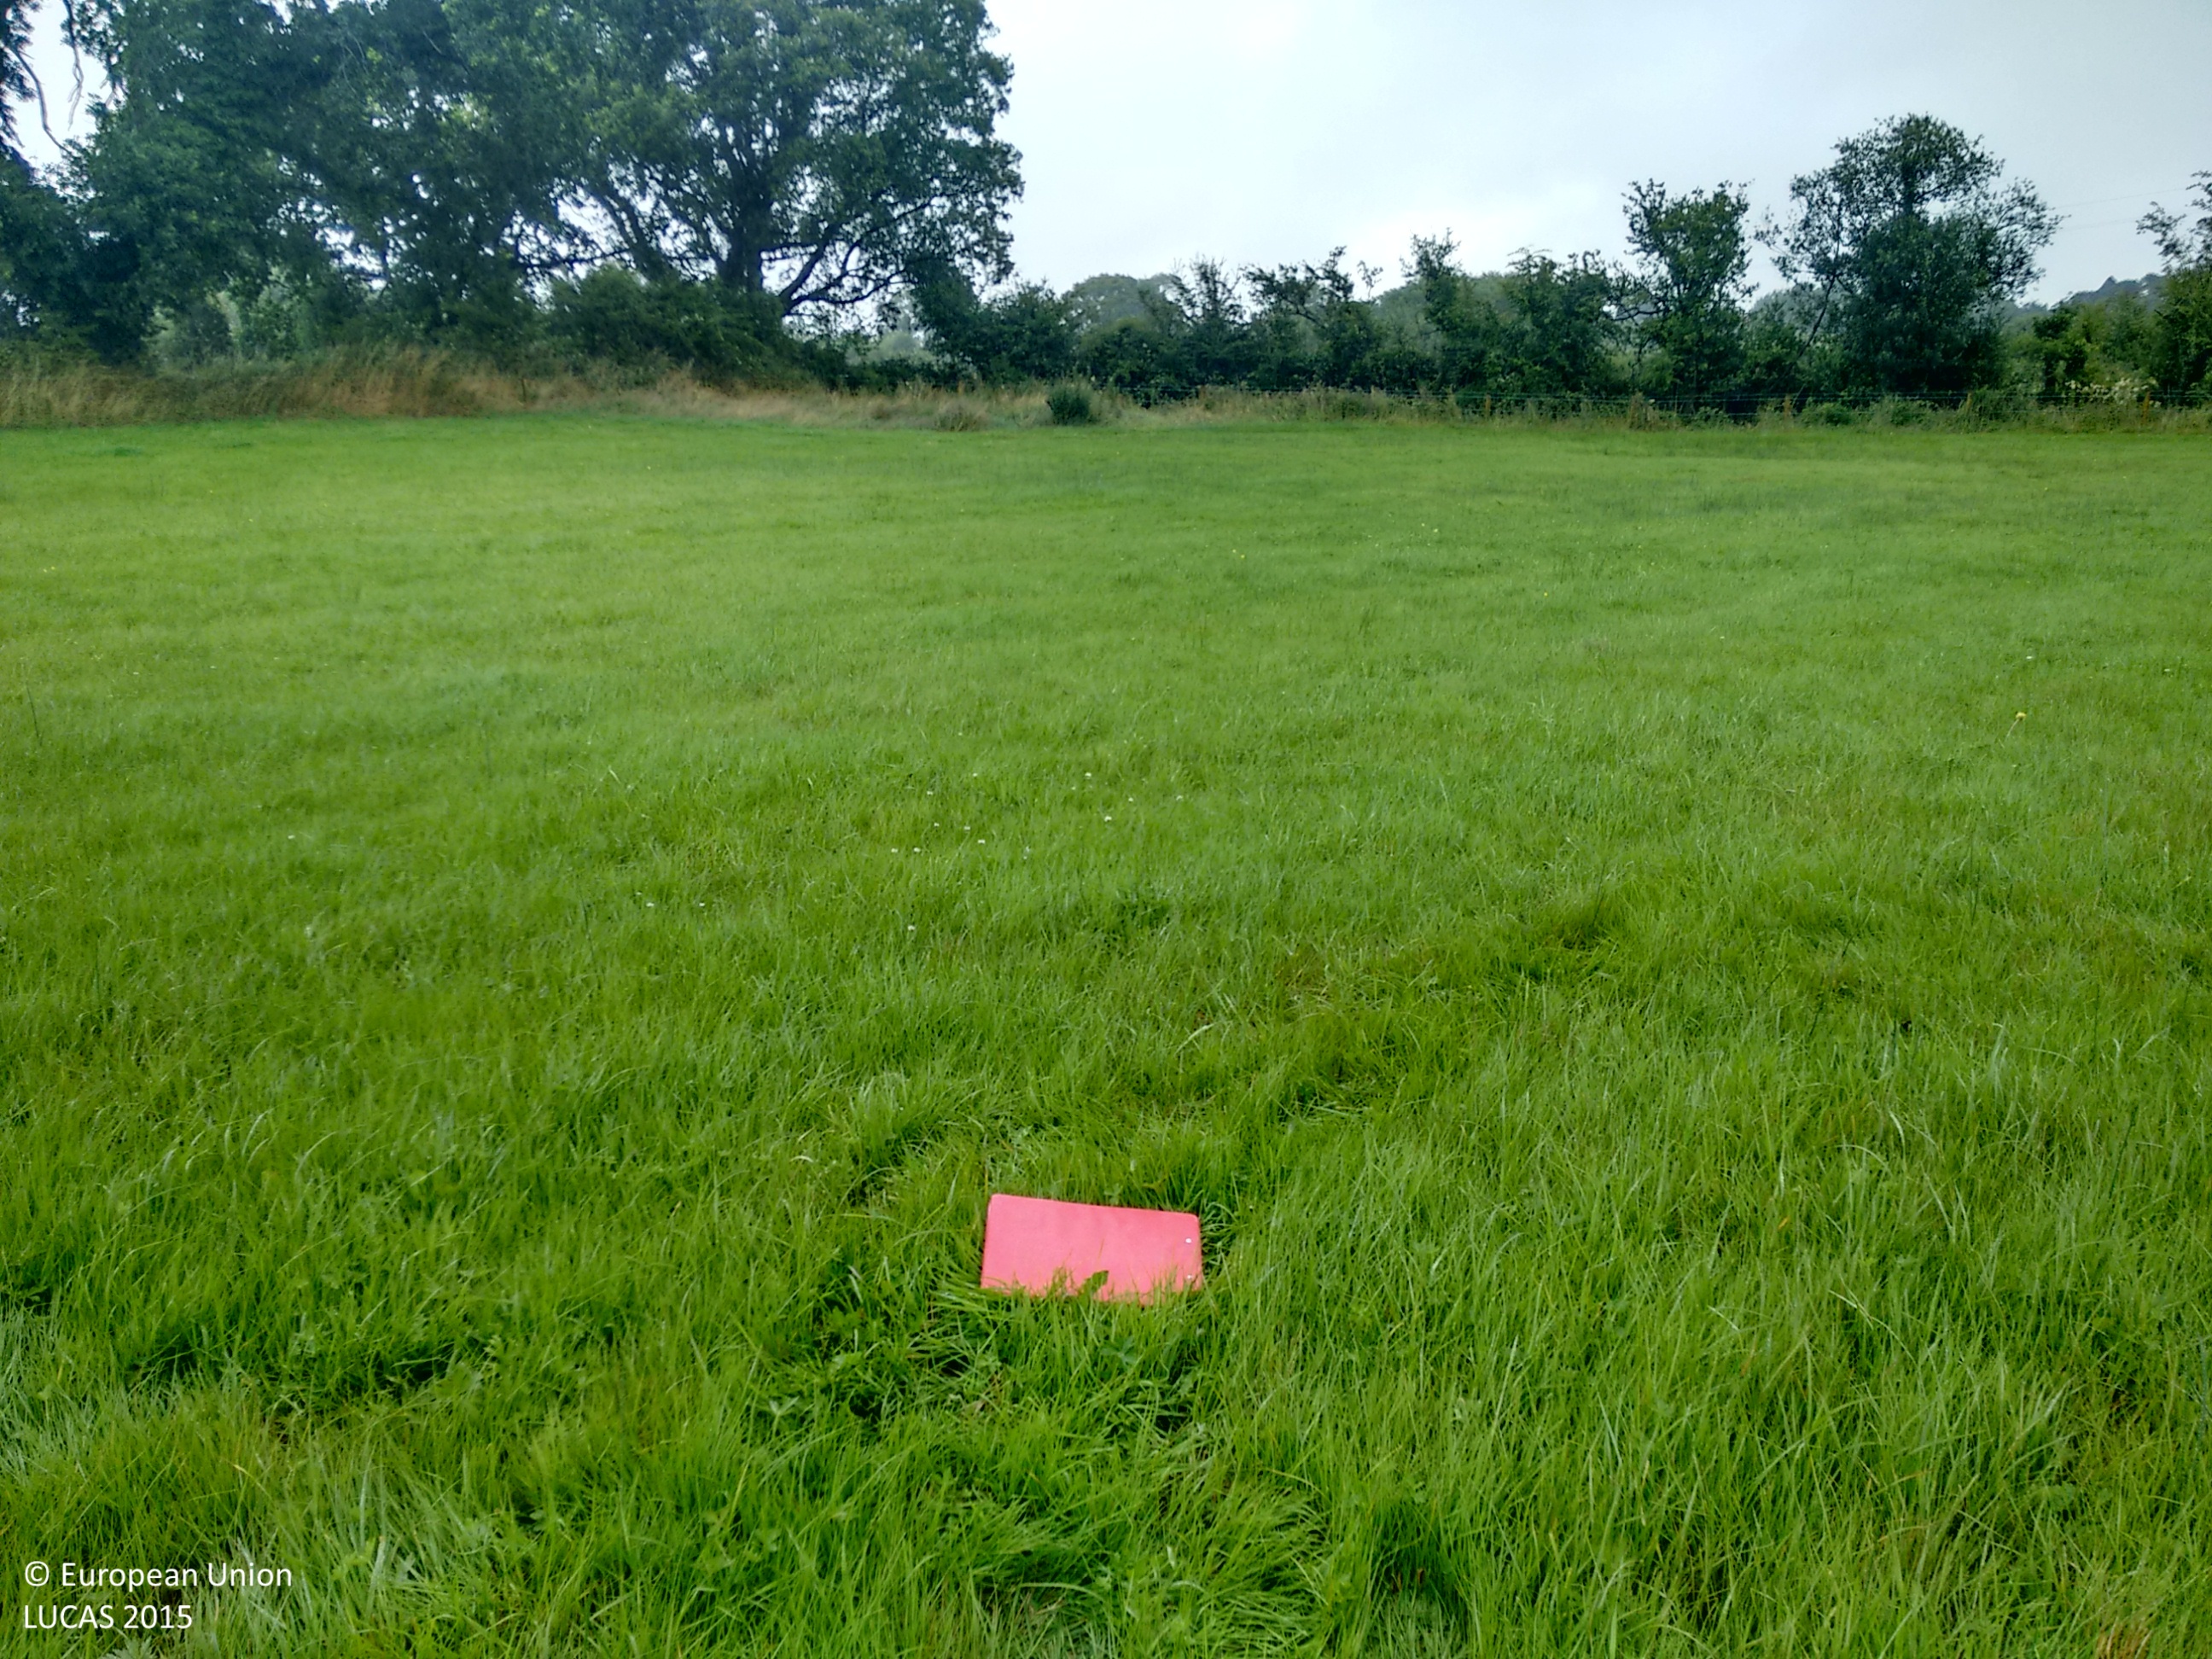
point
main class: Grassland
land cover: Grassland without tree/shrub cover
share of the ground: > 75 %
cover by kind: herbaceous plants 100 %
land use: Agriculture (excluding fallow land and kitchen gardens)
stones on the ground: < 10 %
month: July
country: IE
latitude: 53.7801
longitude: -7.8176
